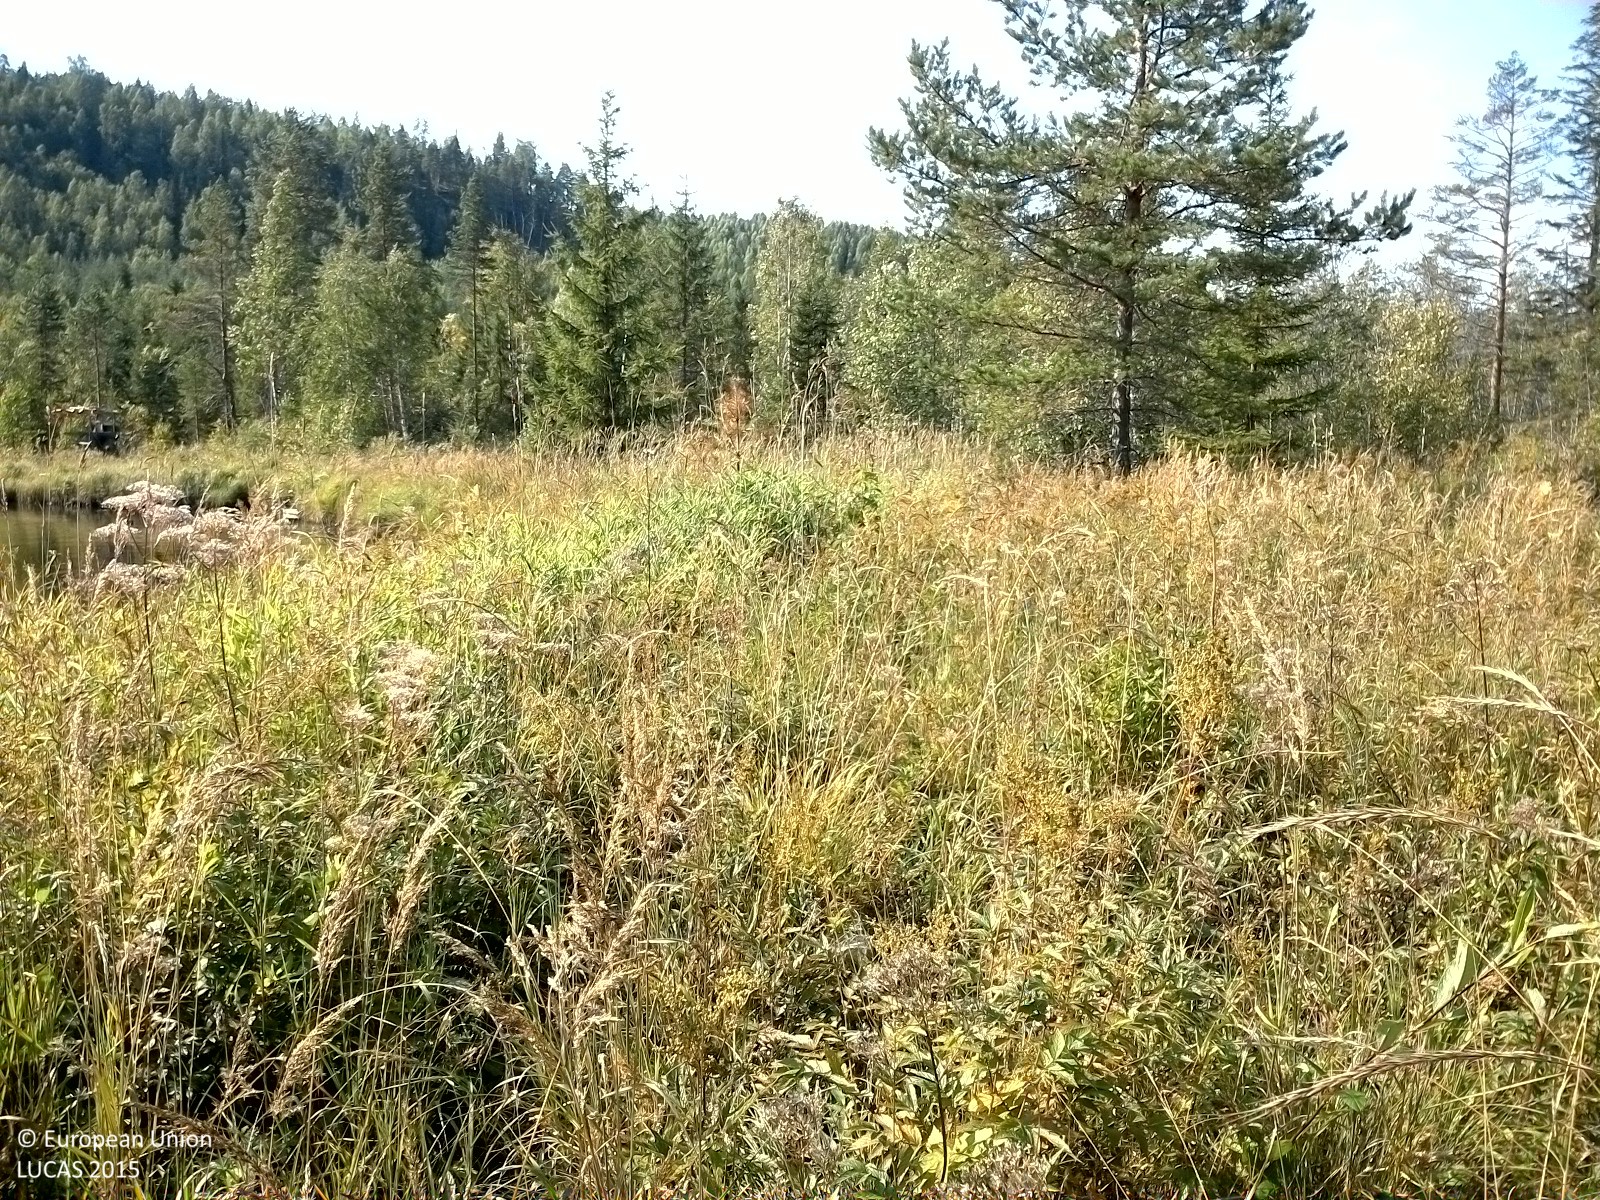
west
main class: Grassland
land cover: Grassland without tree/shrub cover
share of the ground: > 75 %
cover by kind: herbaceous plants 100 %
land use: Semi-natural and natural areas not in use
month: August
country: SE
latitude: 62.4485
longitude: 16.2002
